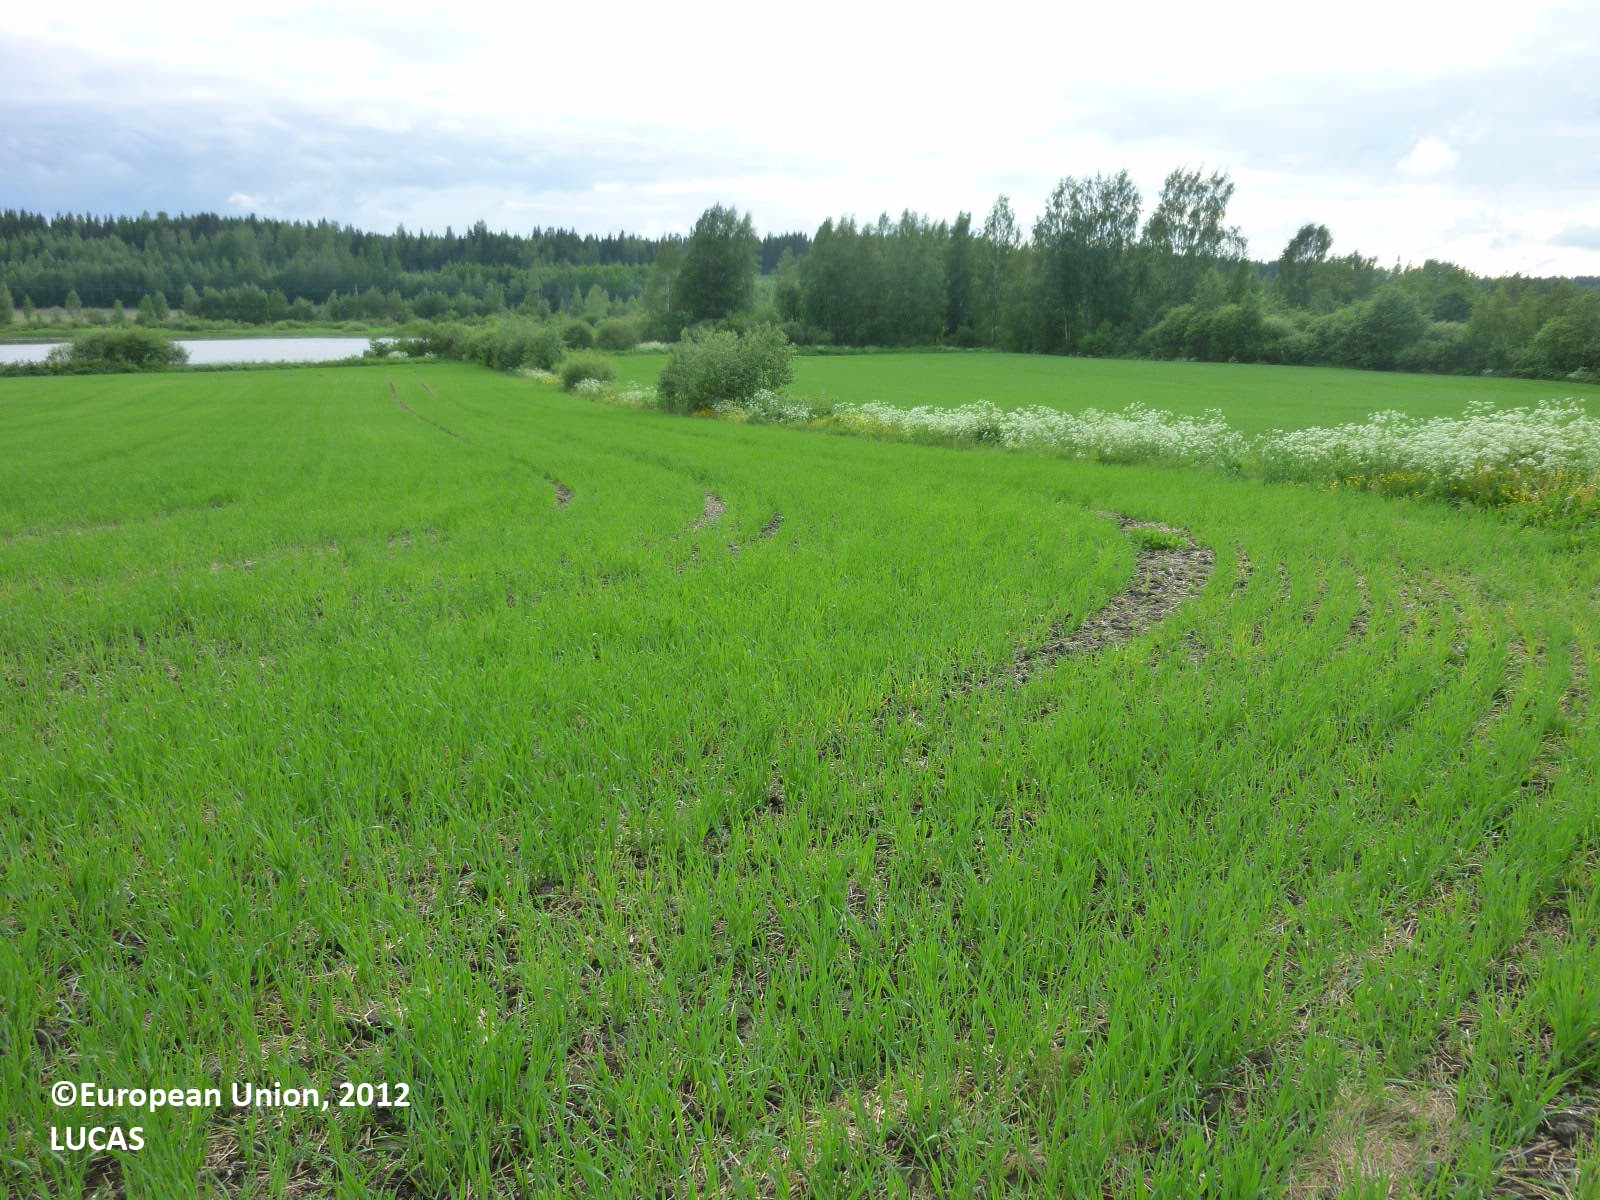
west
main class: Cropland
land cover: Barley
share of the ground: 50 - 75 %
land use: Agriculture (excluding fallow land and kitchen gardens)
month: June
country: FI
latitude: 61.6322
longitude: 22.4956
